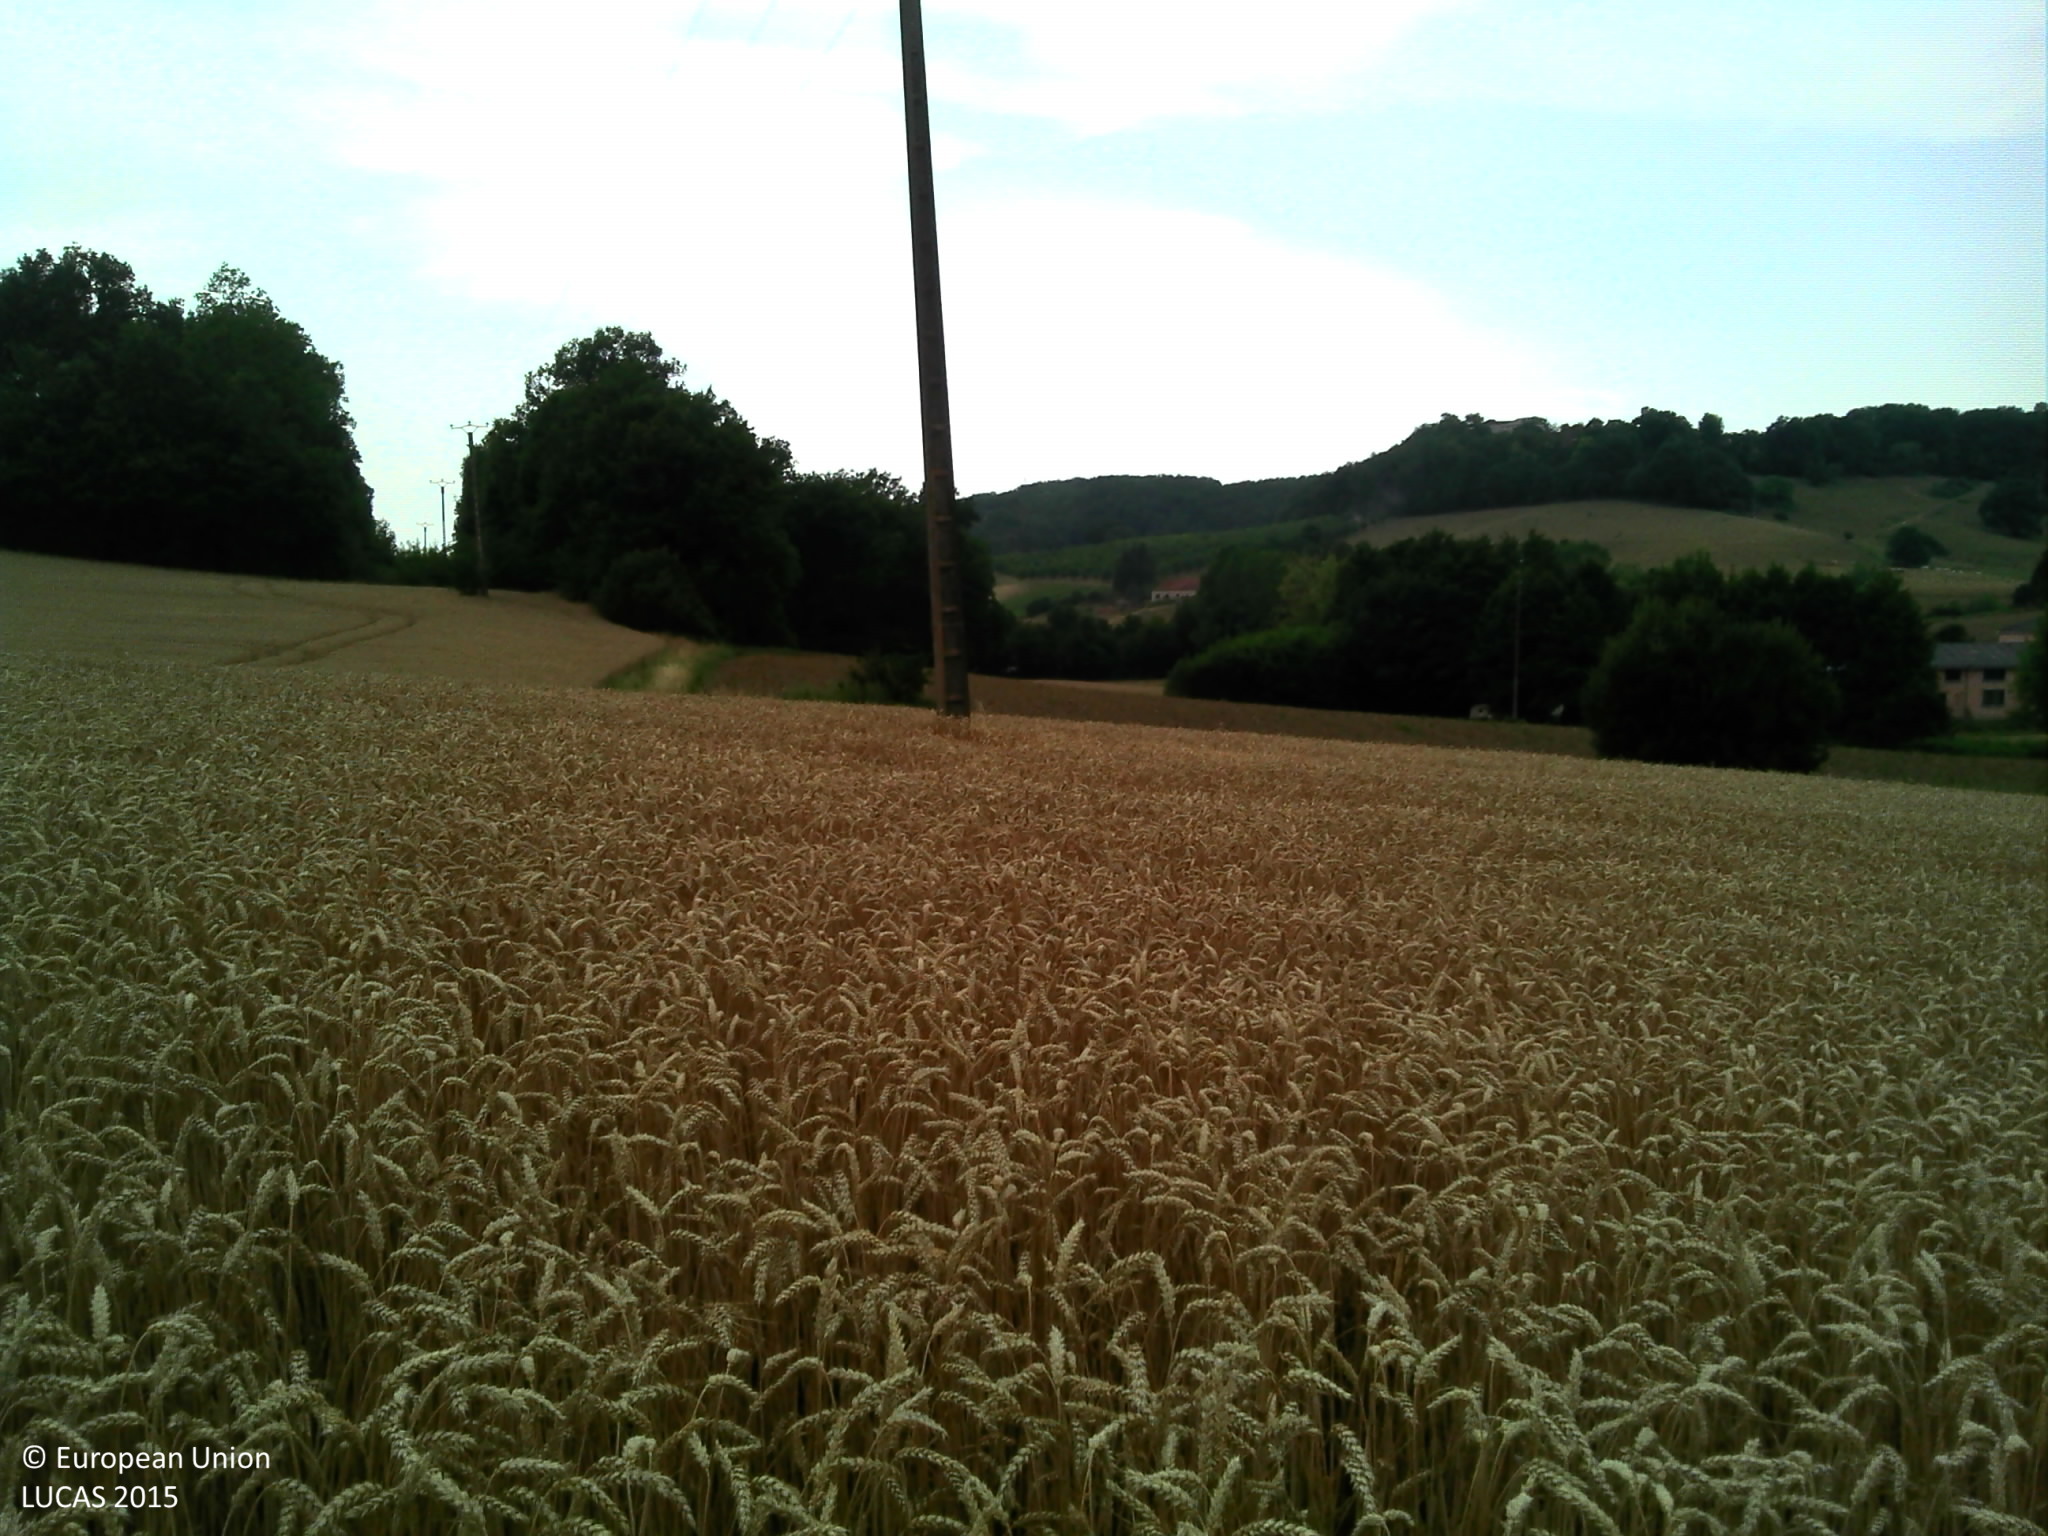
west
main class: Cropland
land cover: Common wheat
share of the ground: > 75 %
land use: Agriculture (excluding fallow land and kitchen gardens)
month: July
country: FR
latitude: 44.3426
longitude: 0.8261
